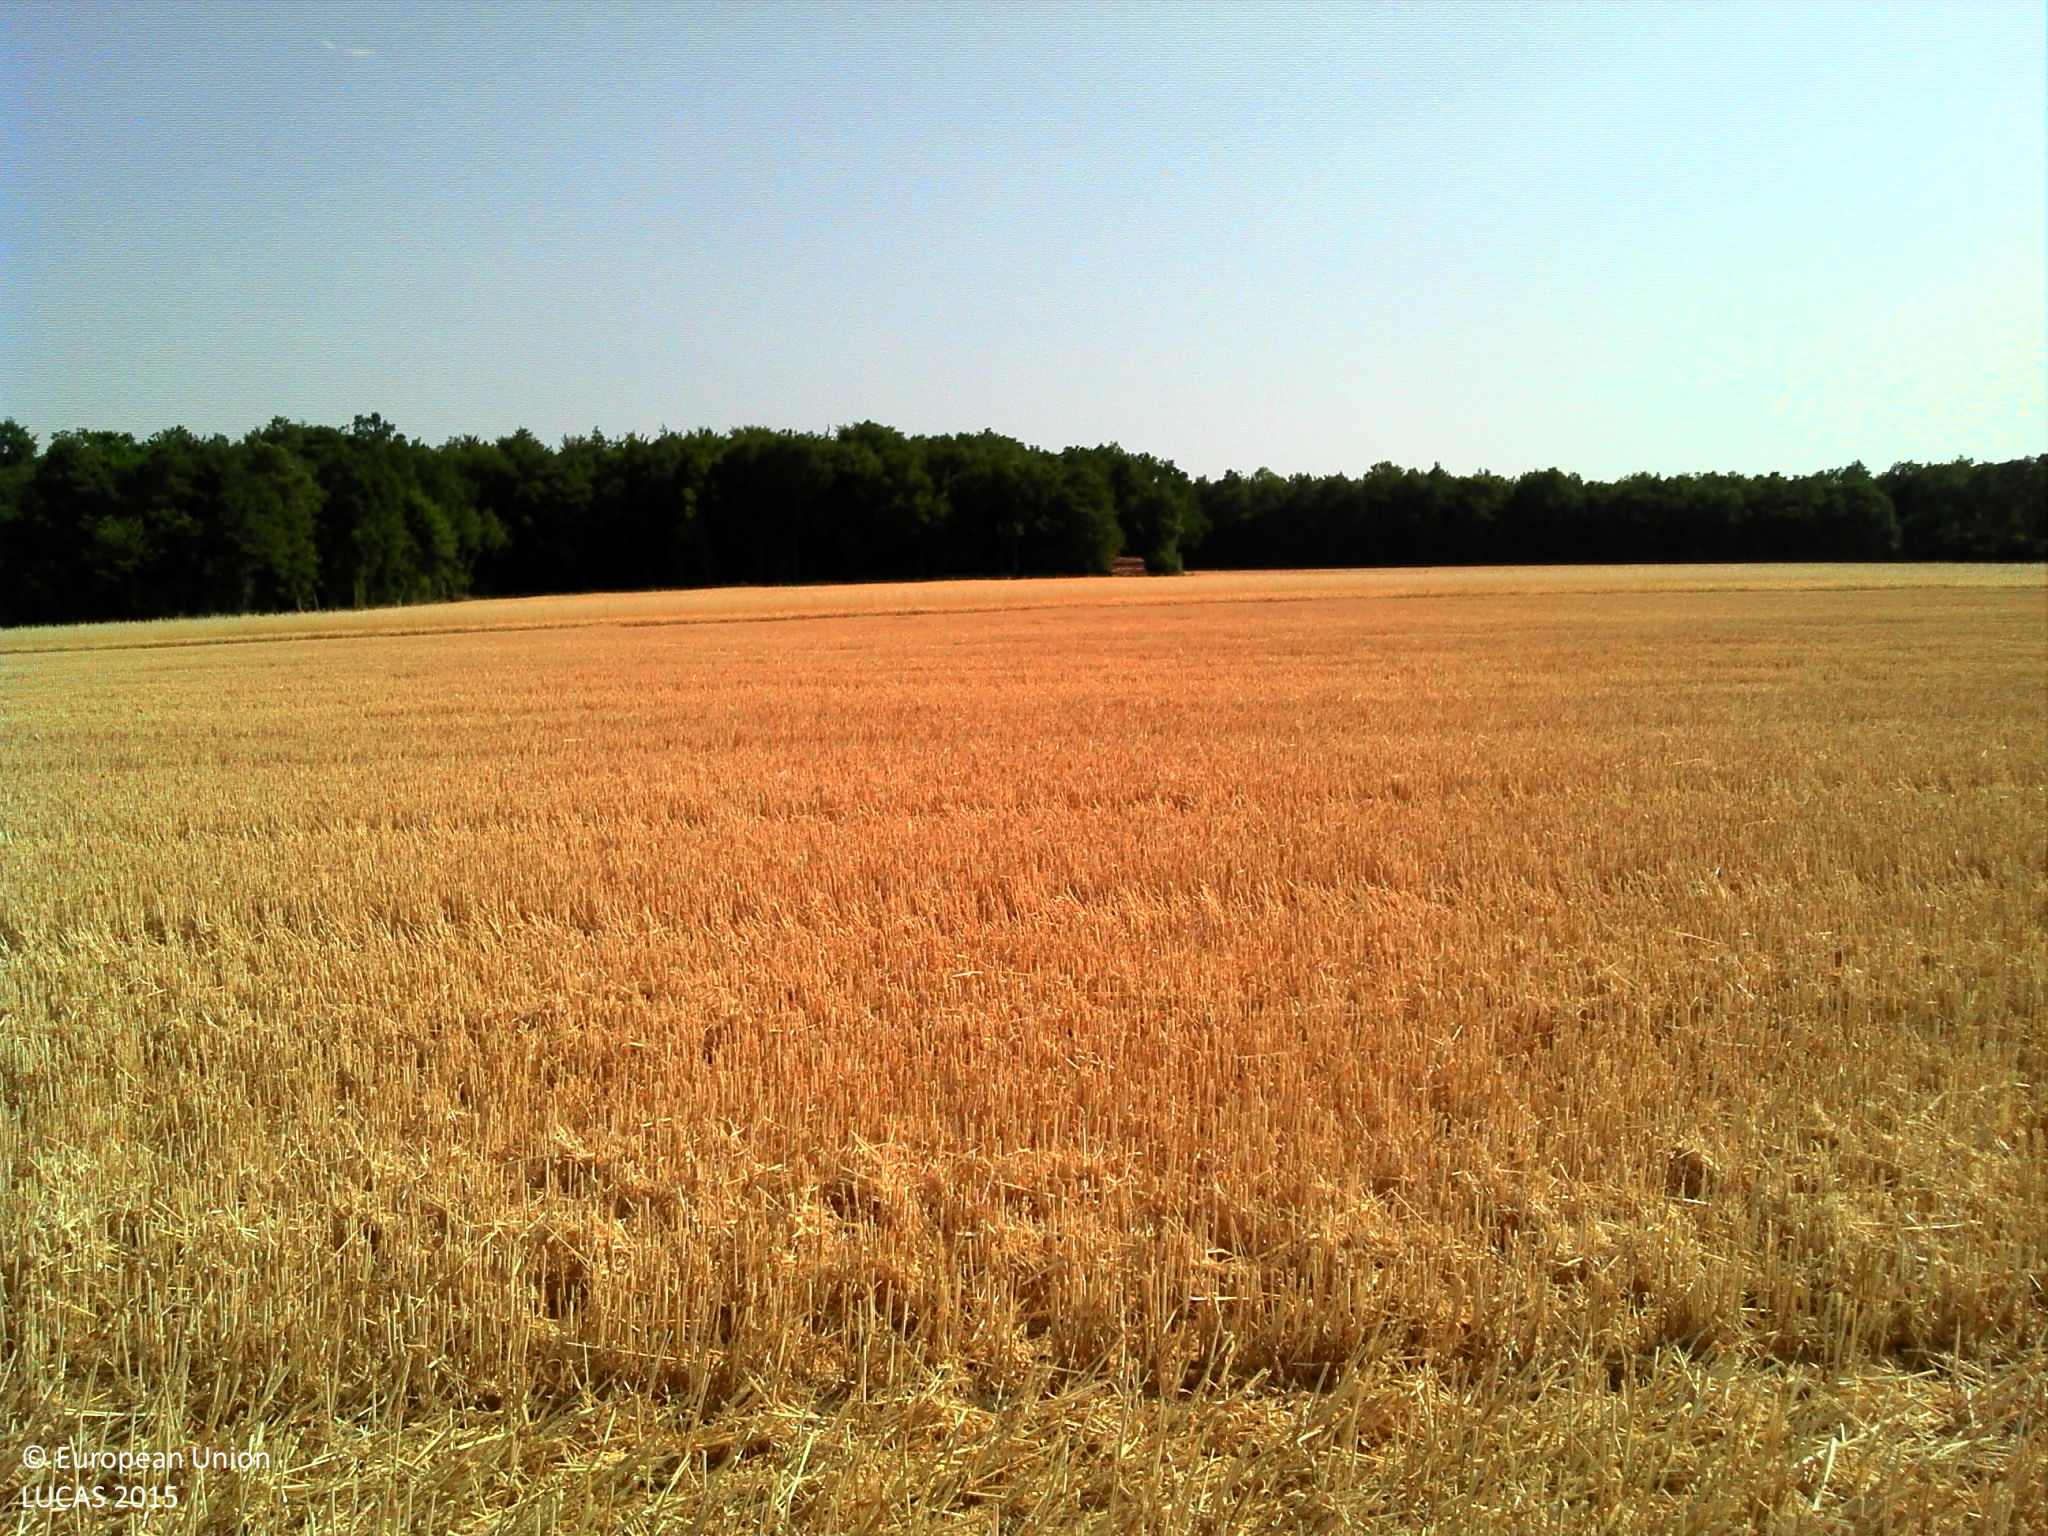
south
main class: Cropland
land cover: Common wheat
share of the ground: 10 - 25 %
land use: Agriculture (excluding fallow land and kitchen gardens)
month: July
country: FR
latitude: 47.9933
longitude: 4.8127
